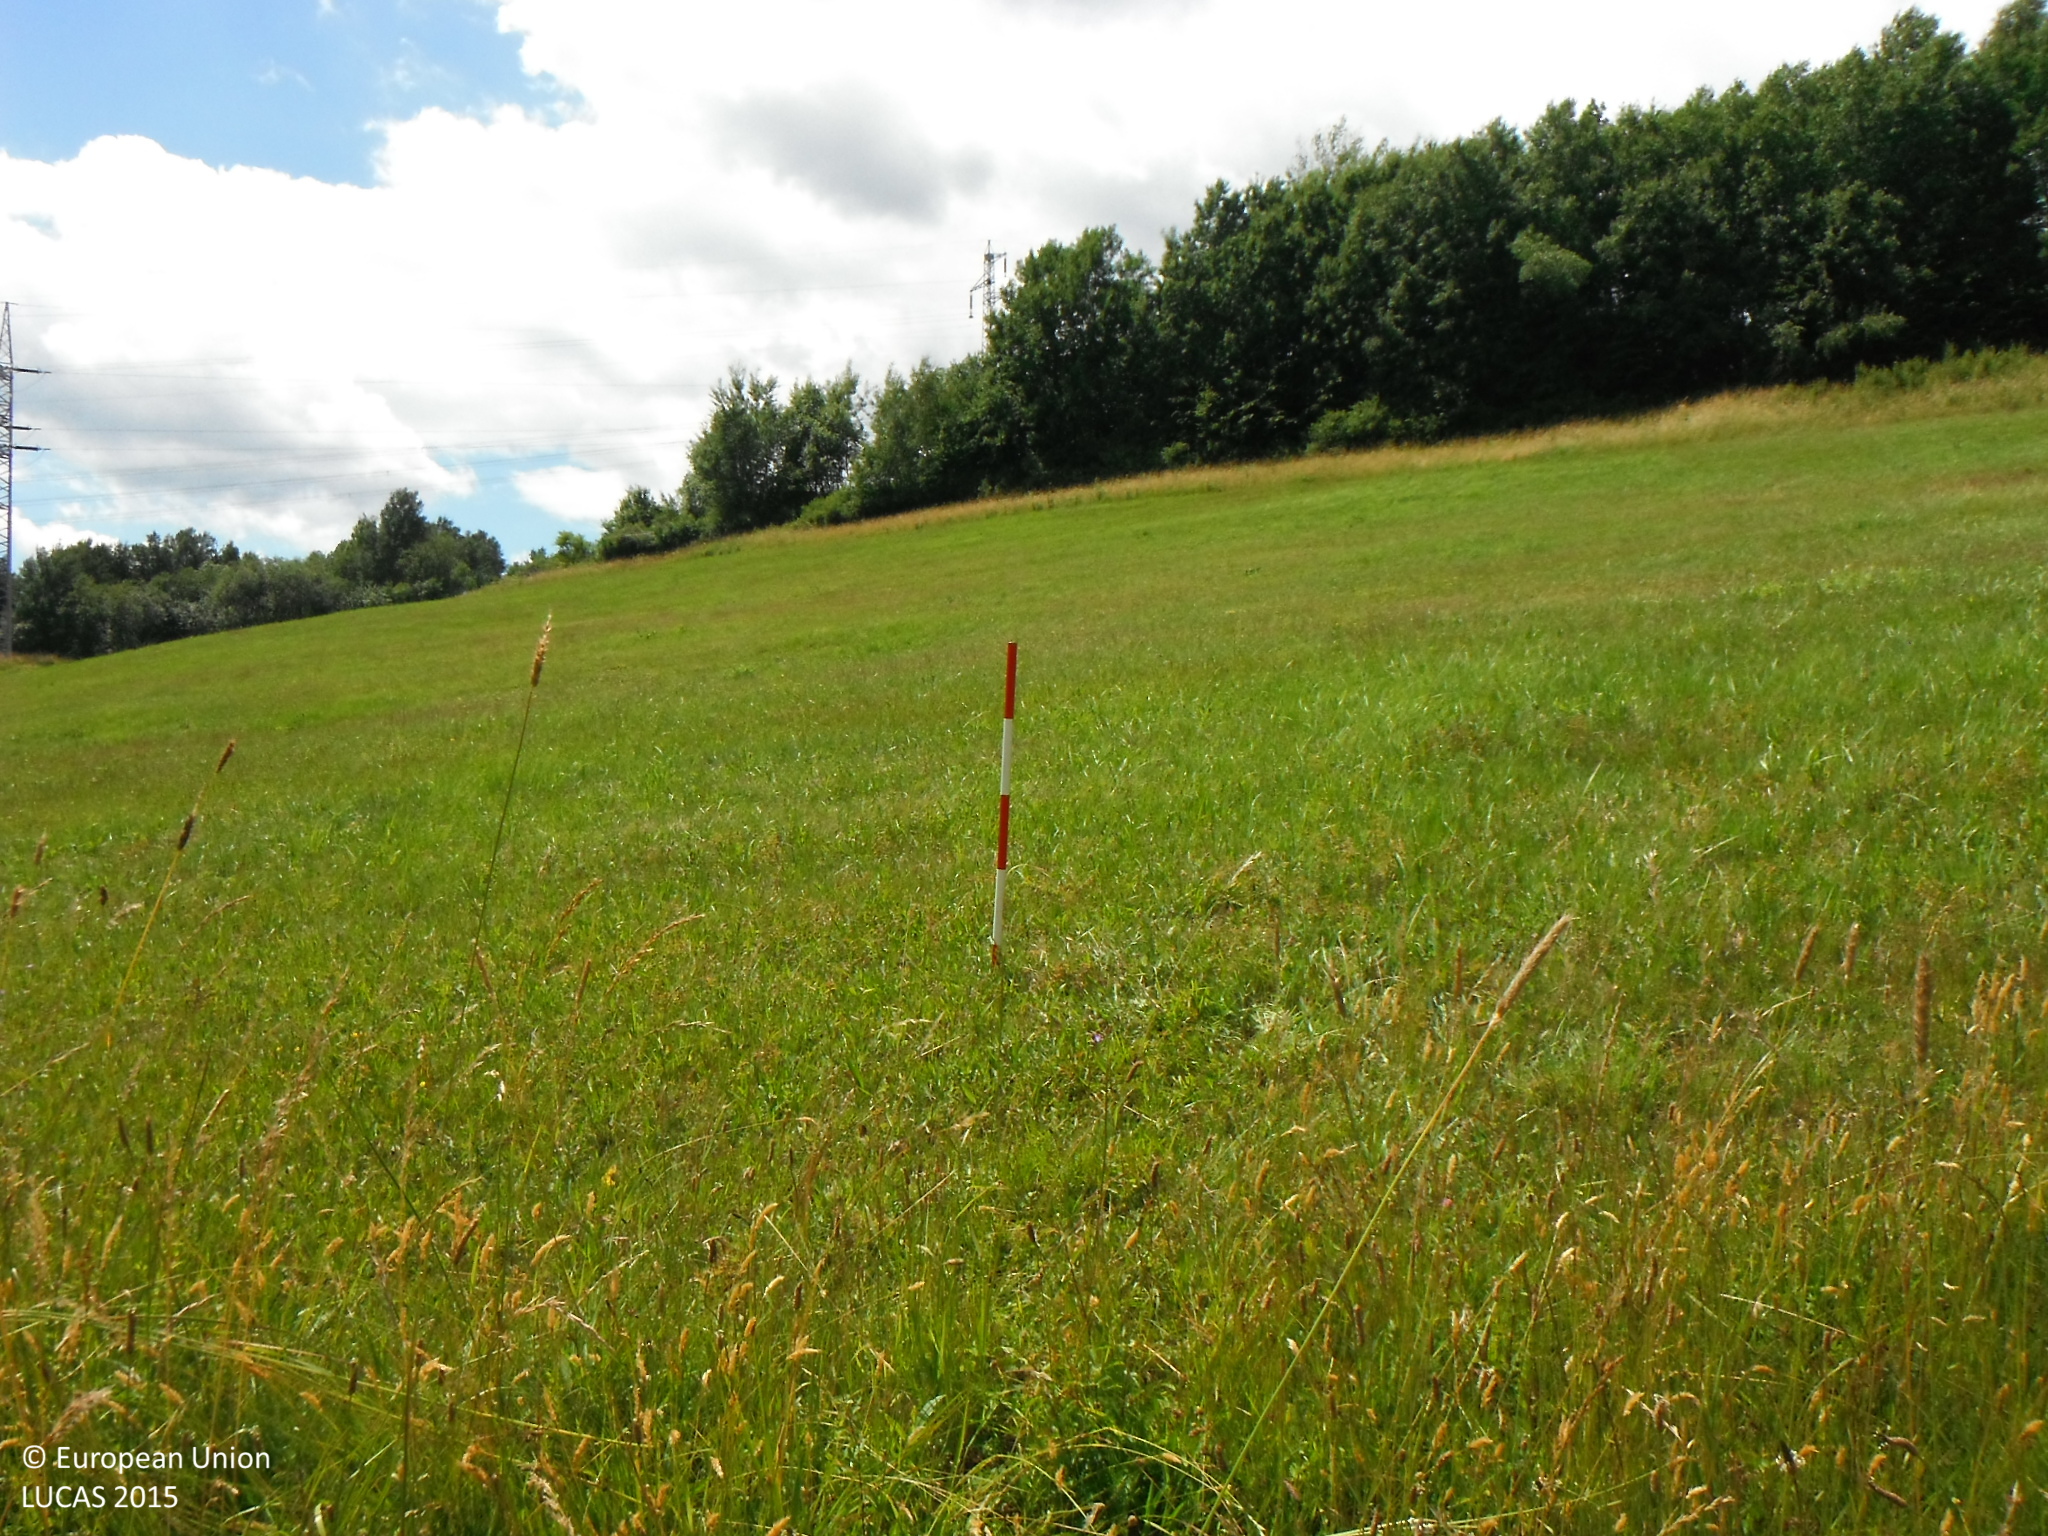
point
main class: Grassland
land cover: Grassland without tree/shrub cover
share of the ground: > 75 %
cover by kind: herbaceous plants 100 %
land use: Agriculture (excluding fallow land and kitchen gardens)
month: June
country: SK
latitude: 48.9078
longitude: 21.1633
